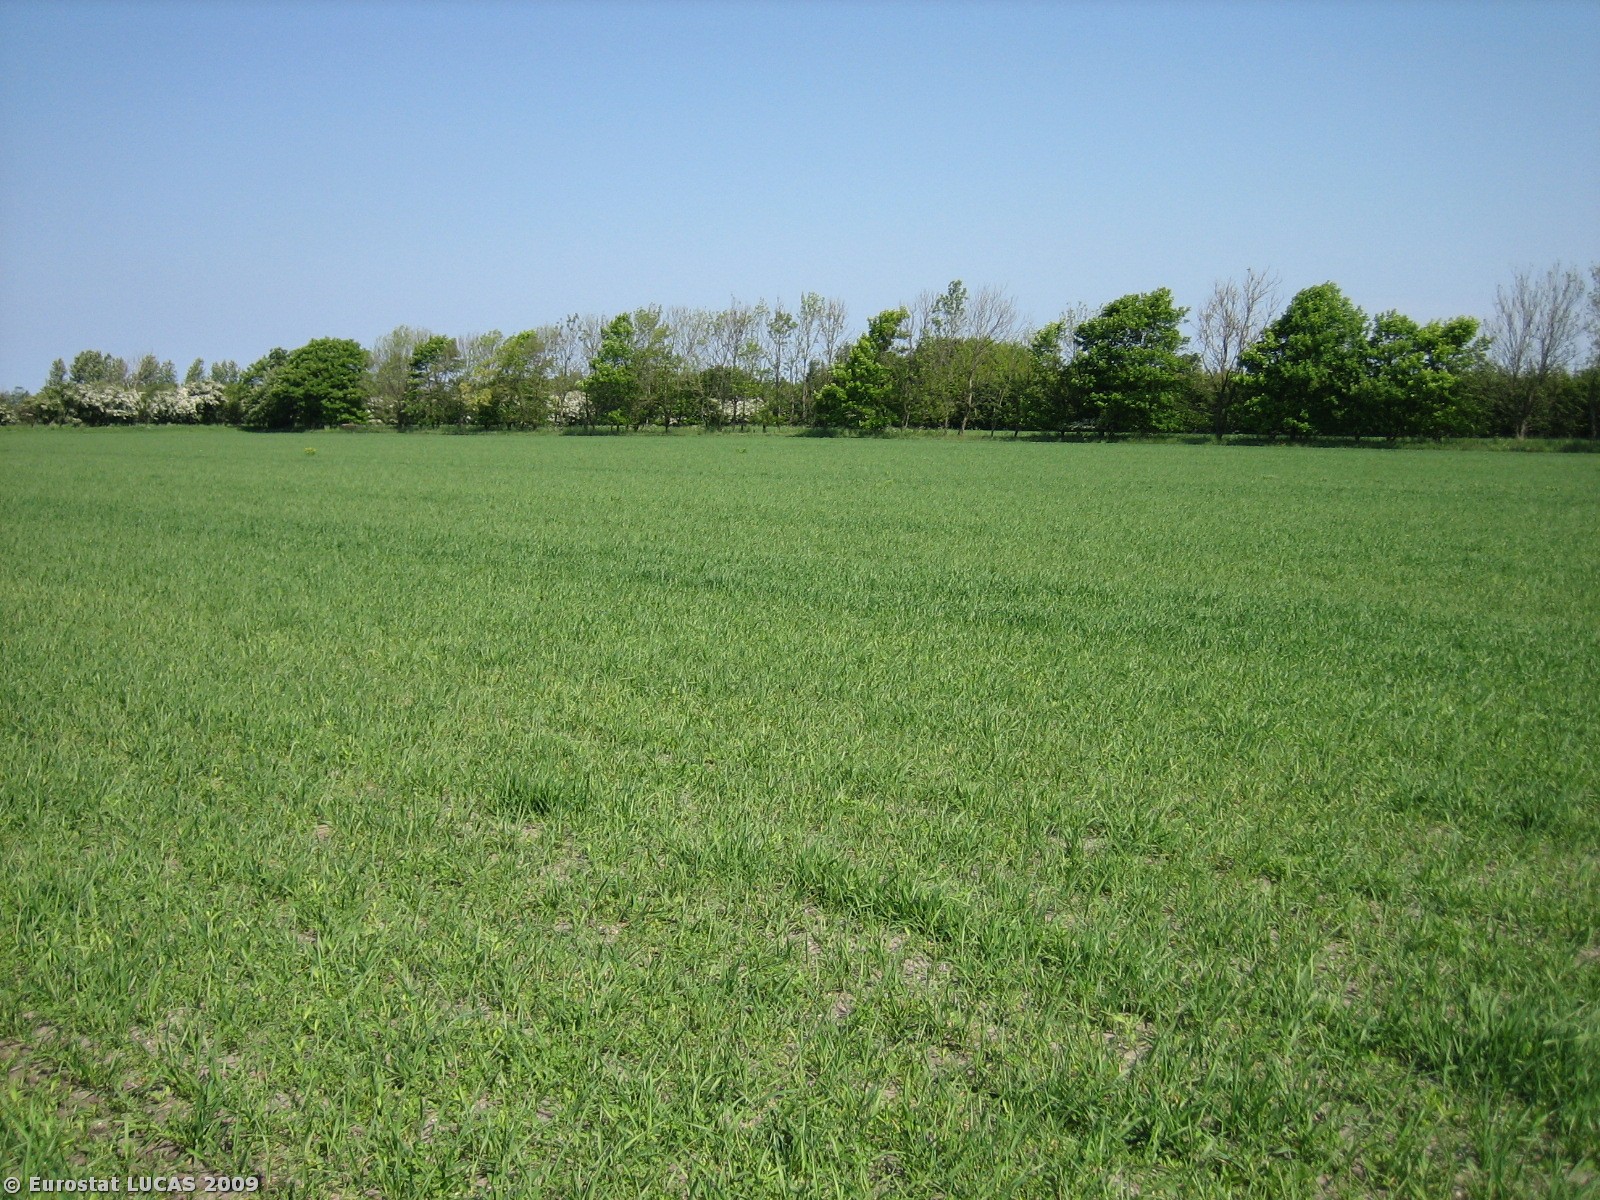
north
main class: Cropland
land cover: Barley
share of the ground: 50 - 75 %
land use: Agriculture (excluding fallow land and kitchen gardens)
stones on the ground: < 10 %
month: May
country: DK
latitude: 56.1314
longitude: 9.2125
